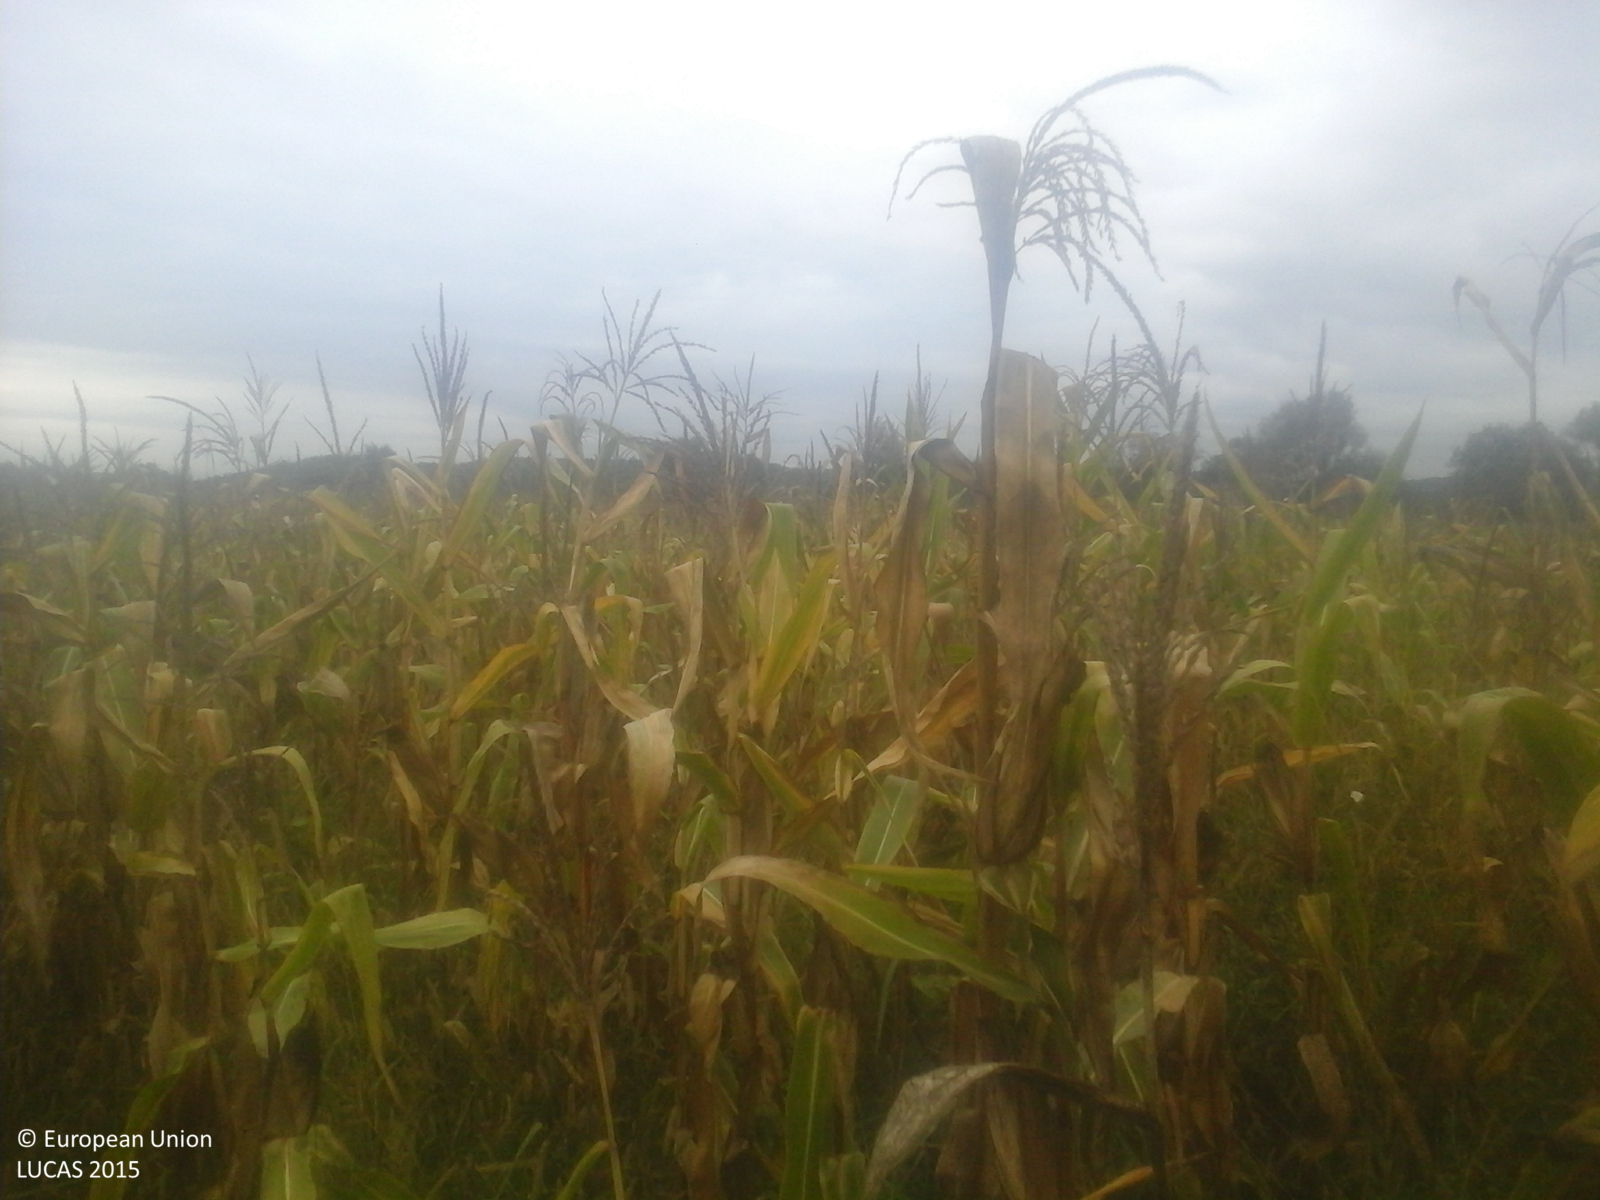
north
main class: Cropland
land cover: Maize
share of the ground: > 75 %
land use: Agriculture (excluding fallow land and kitchen gardens)
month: September
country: RO
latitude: 46.8123
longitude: 22.2241
